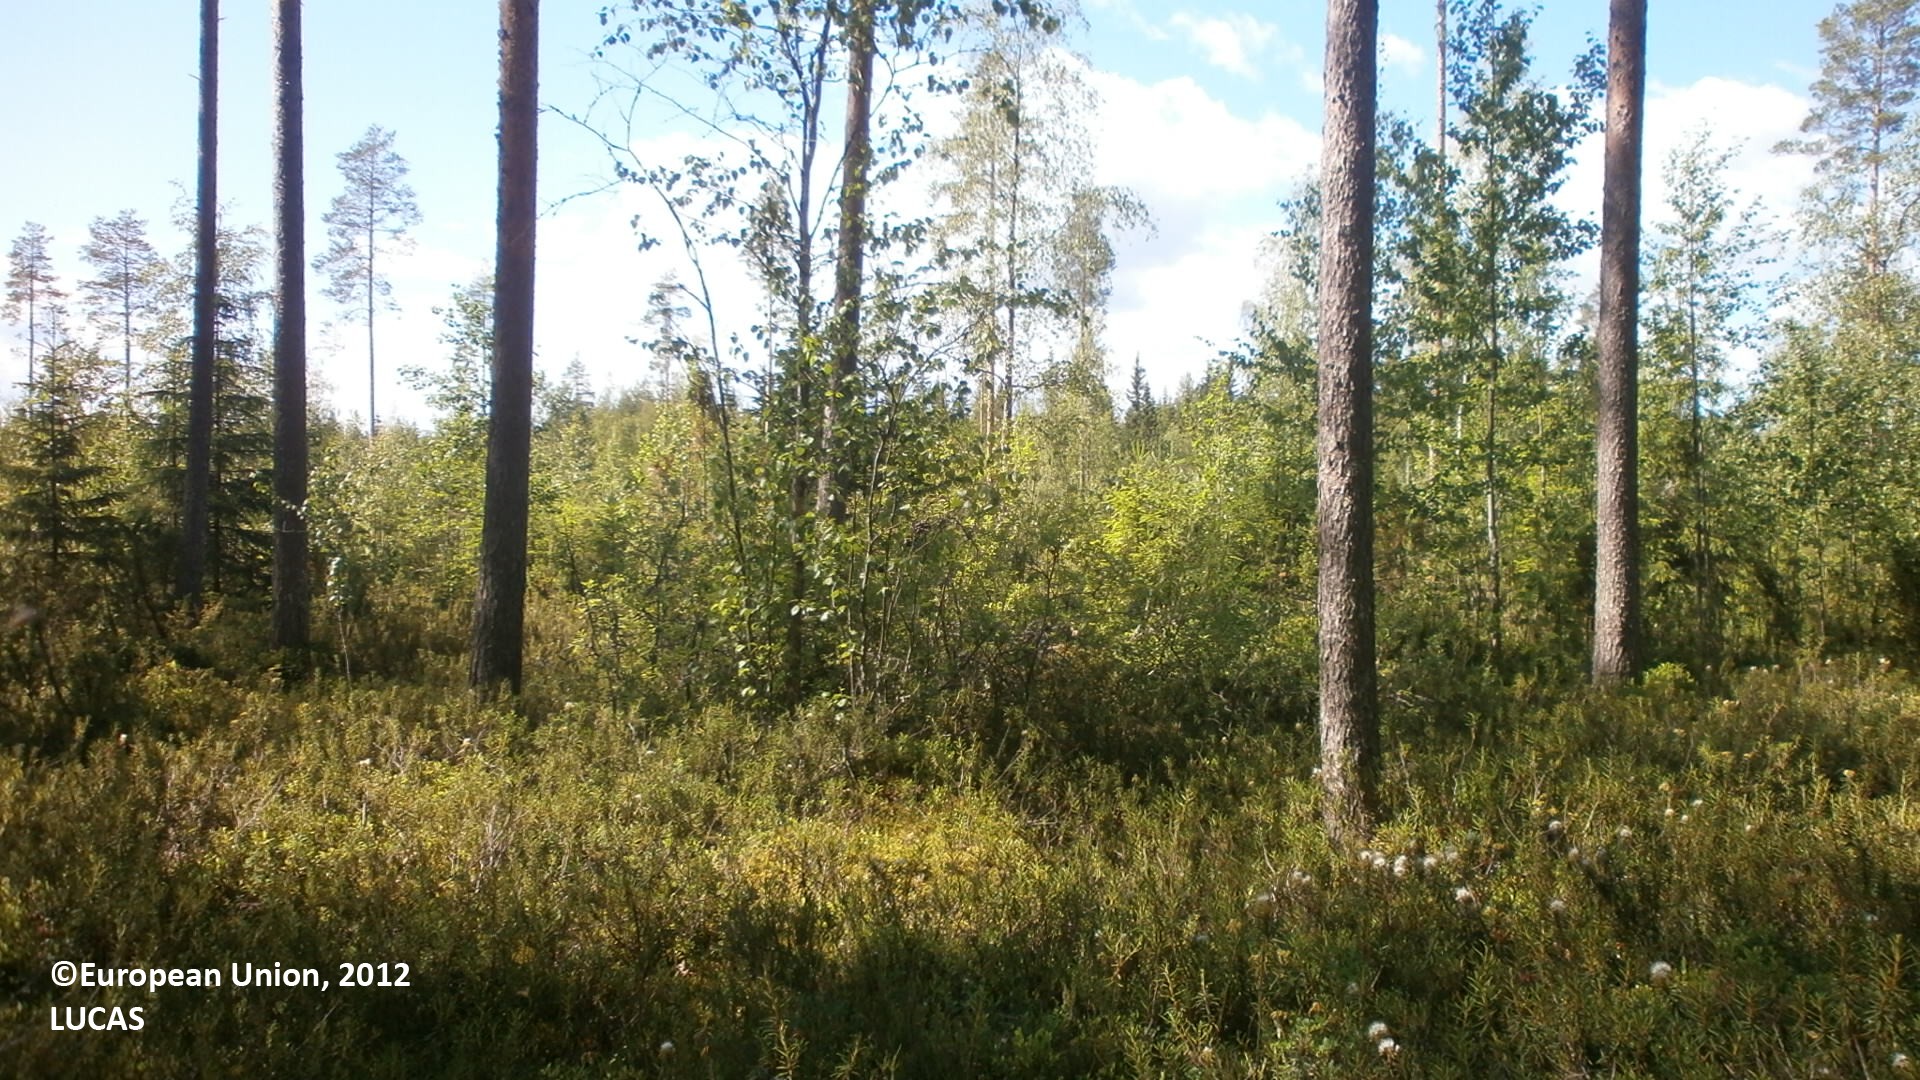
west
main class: Woodland
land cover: Pine dominated coniferous woodland
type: boreal forest
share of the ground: 50 - 75 %
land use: Forestry
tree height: > 5 m
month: July
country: FI
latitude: 63.9746
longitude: 24.8092
